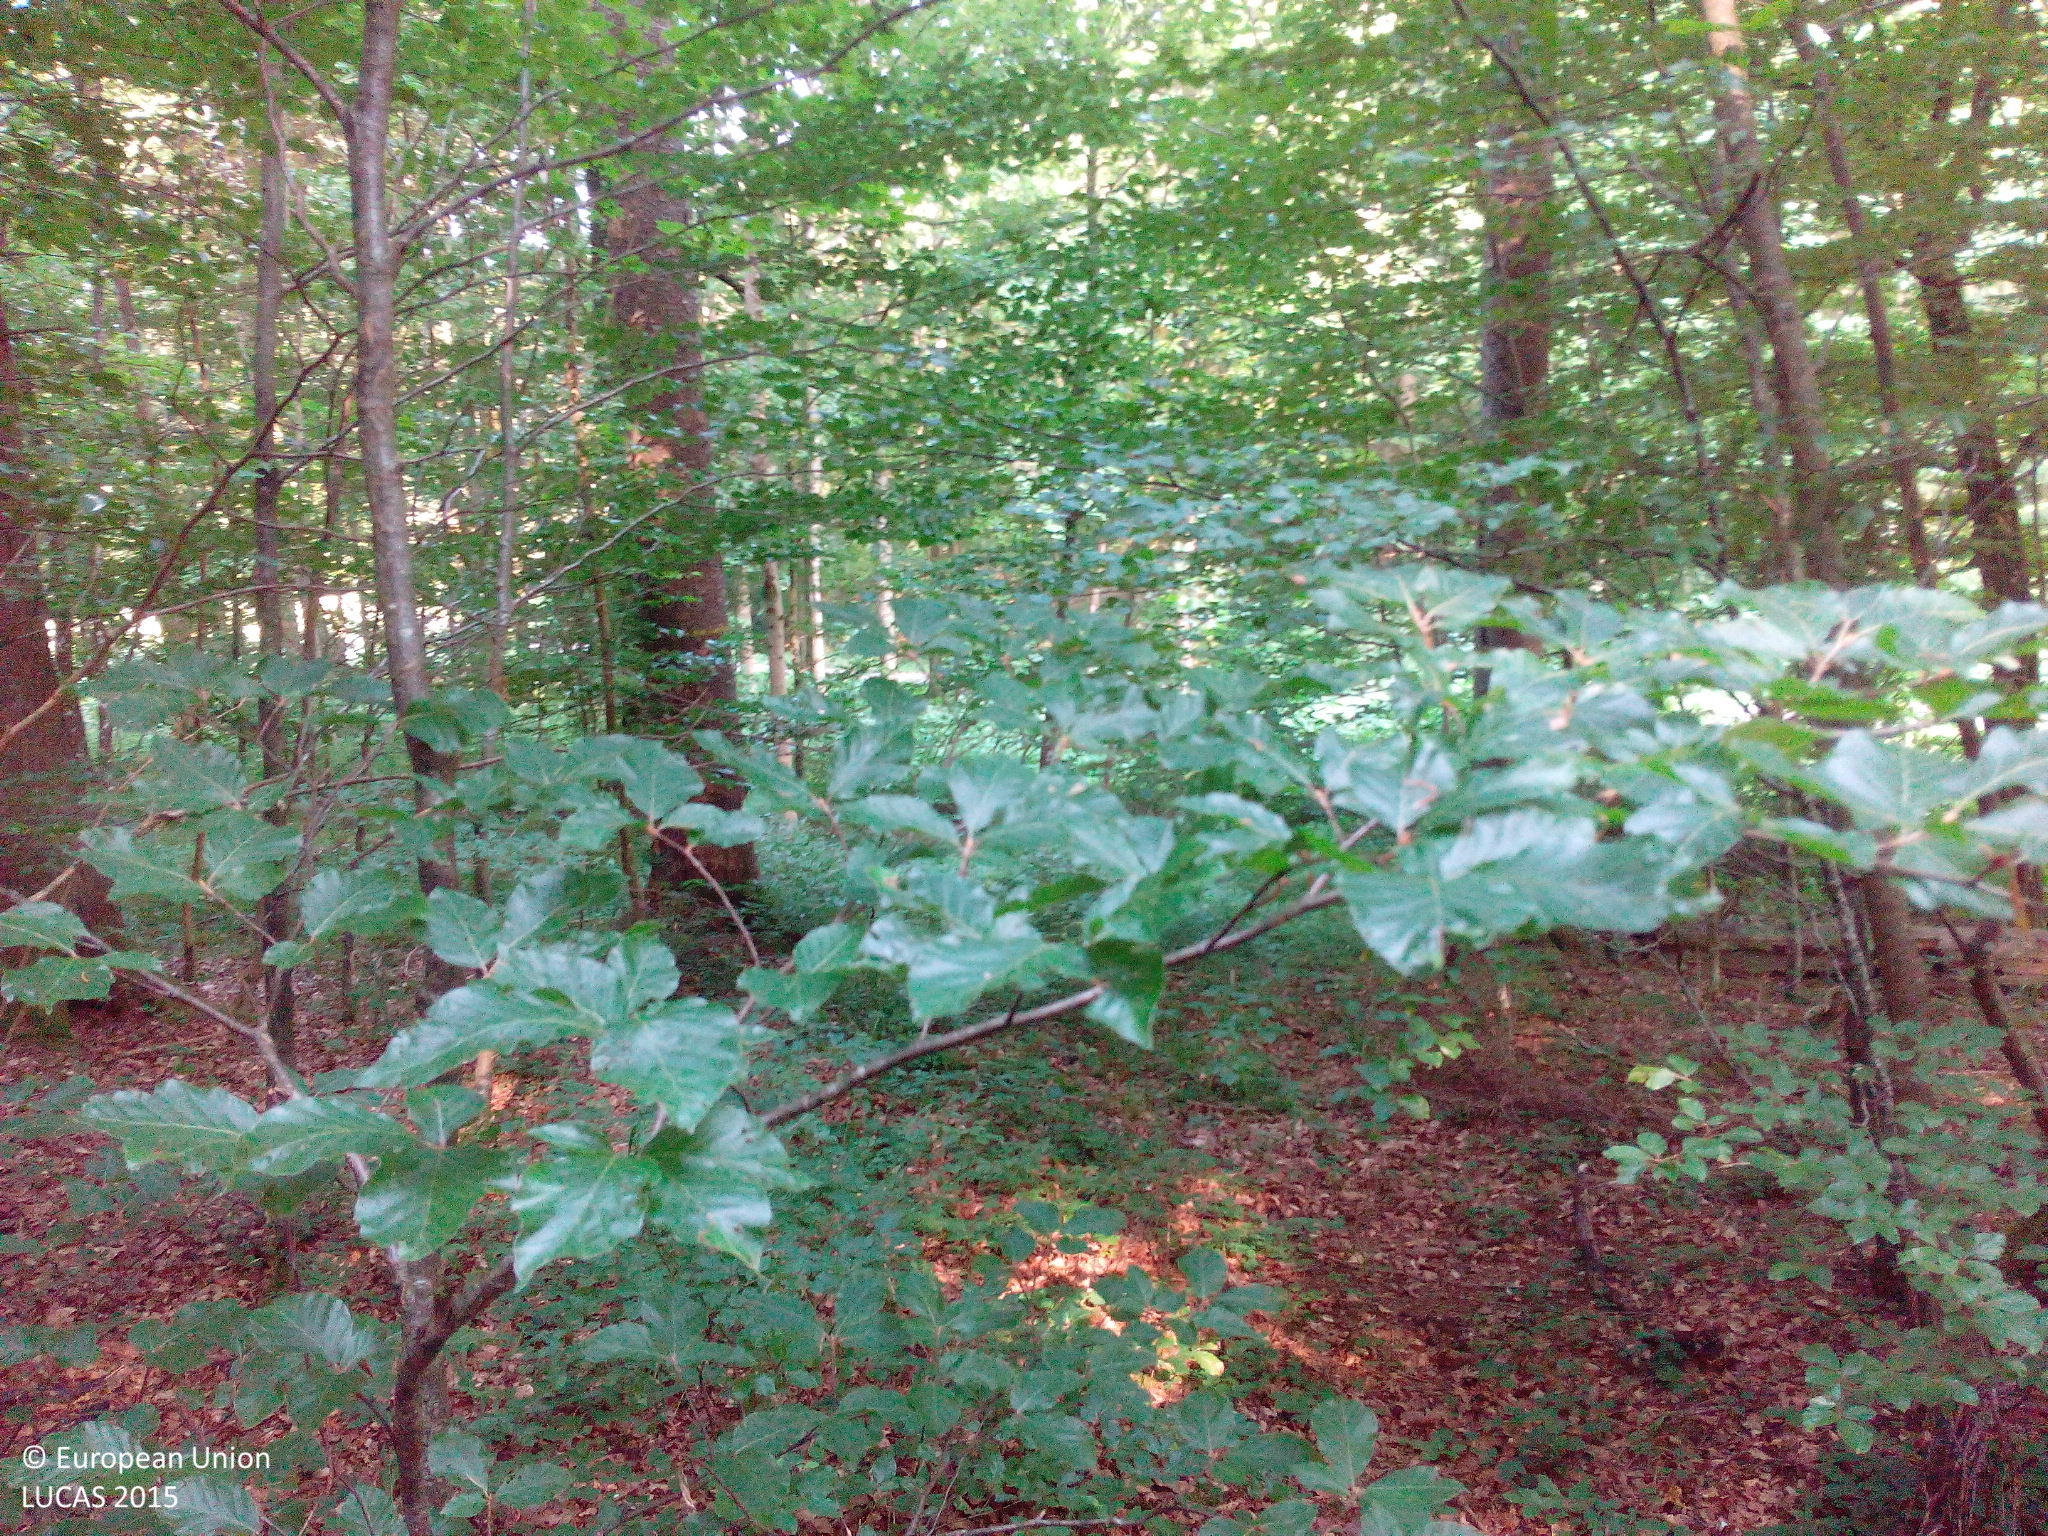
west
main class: Woodland
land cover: Broadleaved woodland
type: mesophytic deciduous forest
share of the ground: > 75 %
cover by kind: broadleaved forest trees 95 %, unconsolidated bare surface 5 %
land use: Forestry
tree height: > 5 m
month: July
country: DE
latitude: 48.1494
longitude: 9.3149
